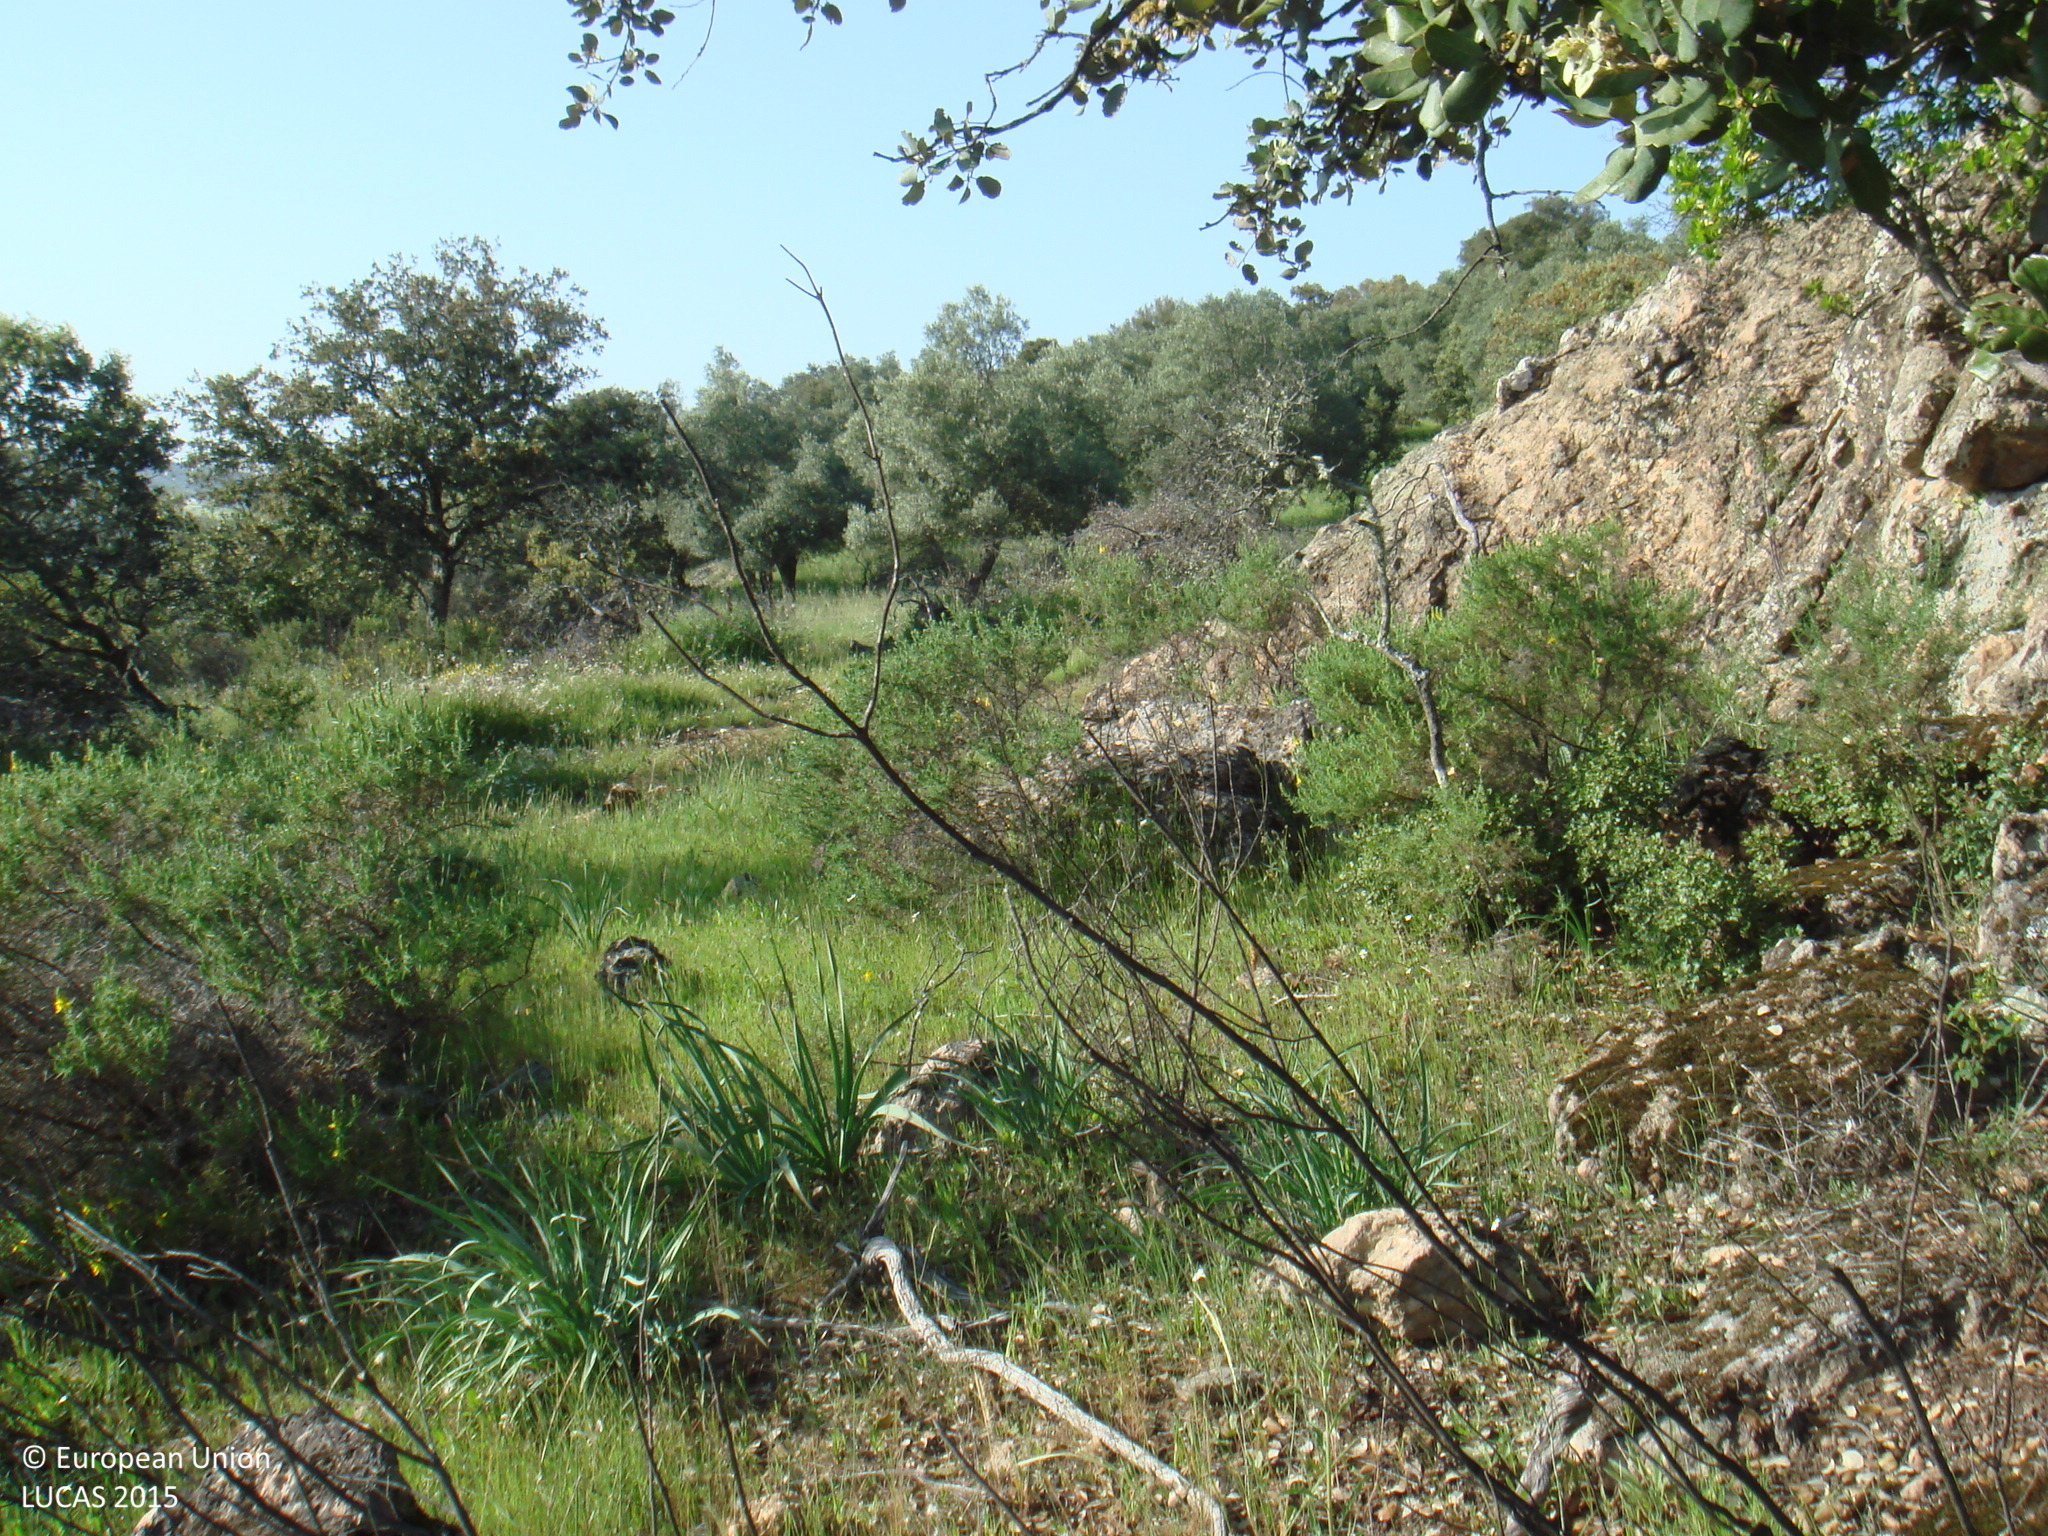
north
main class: Woodland
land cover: Broadleaved woodland
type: broadleaved evergreen forest
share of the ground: > 75 %
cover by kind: broadleaved forest trees 75 %, herbaceous plants 15 %, shrubs 10 %
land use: Forestry
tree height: > 5 m
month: April
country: ES
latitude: 38.1642
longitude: -5.2631
